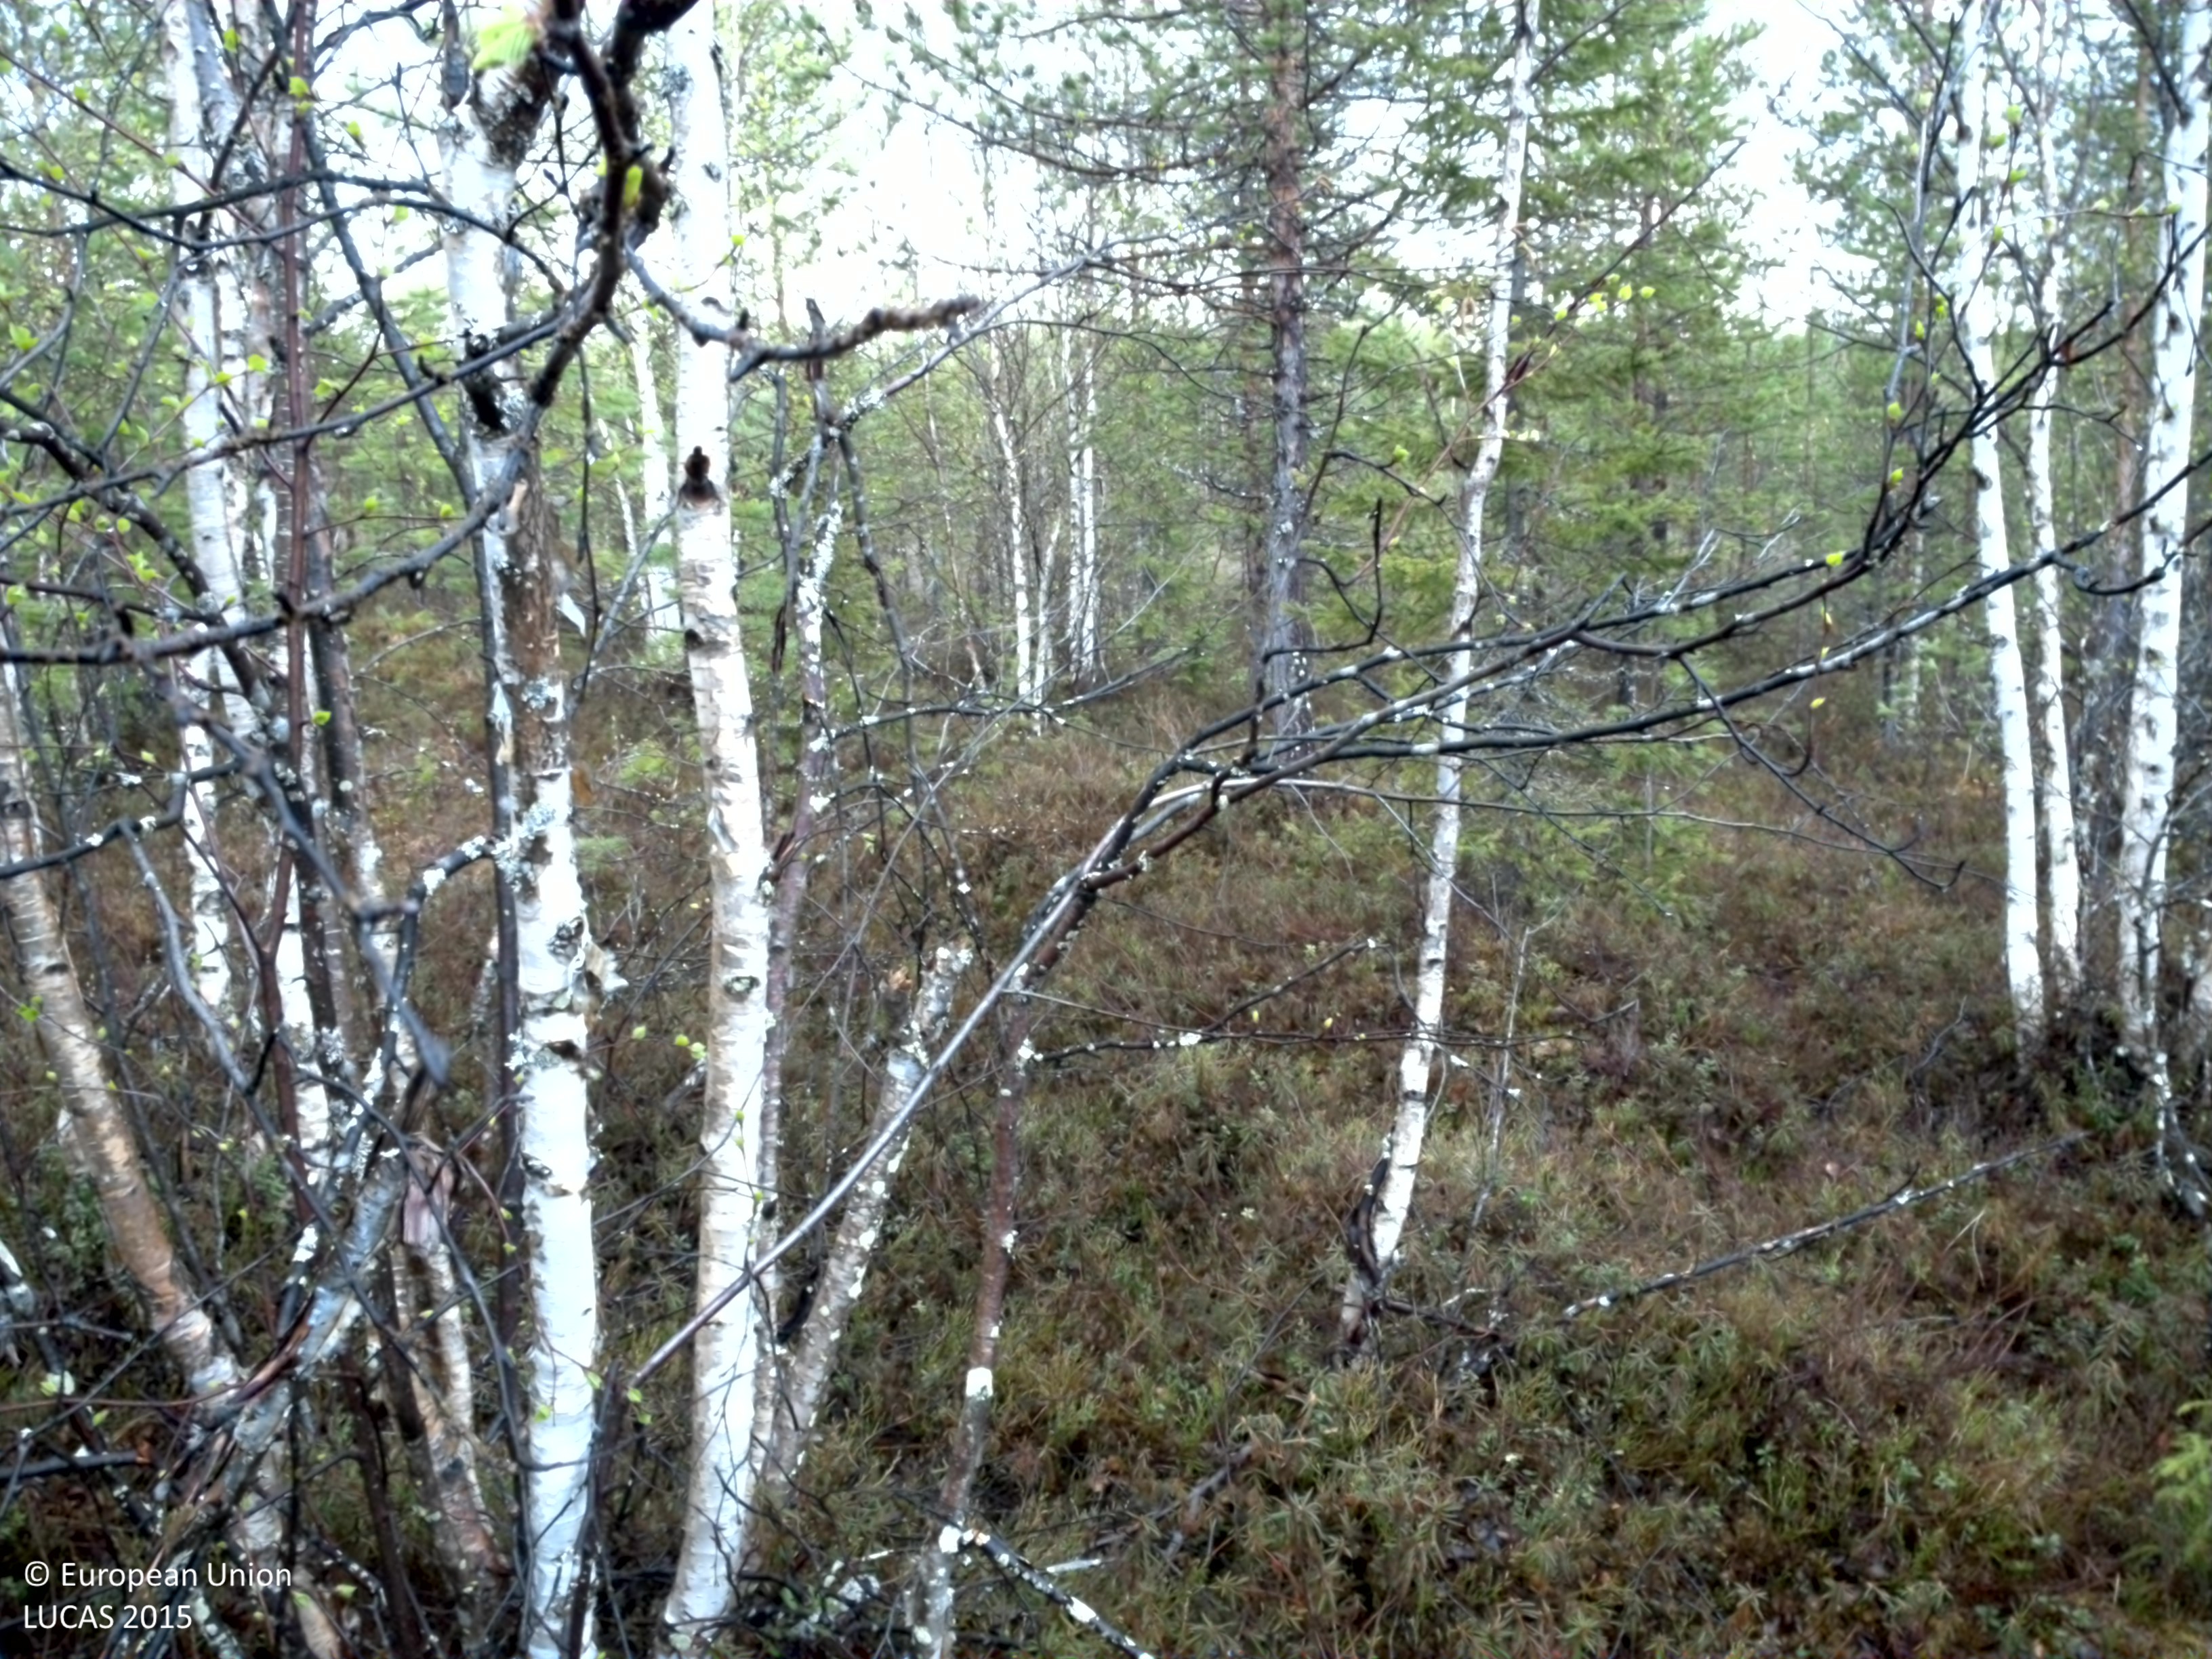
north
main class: Woodland
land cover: Pine dominated mixed woodland
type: boreal forest
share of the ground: 50 - 75 %
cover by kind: shrubs 40 %, coniferous forest trees 25 %, broadleaved forest trees 25 %, lichens and mosses 10 %
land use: Forestry
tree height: > 5 m
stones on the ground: 25 - 50 %
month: May
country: SE
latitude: 66.2185
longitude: 23.1619
